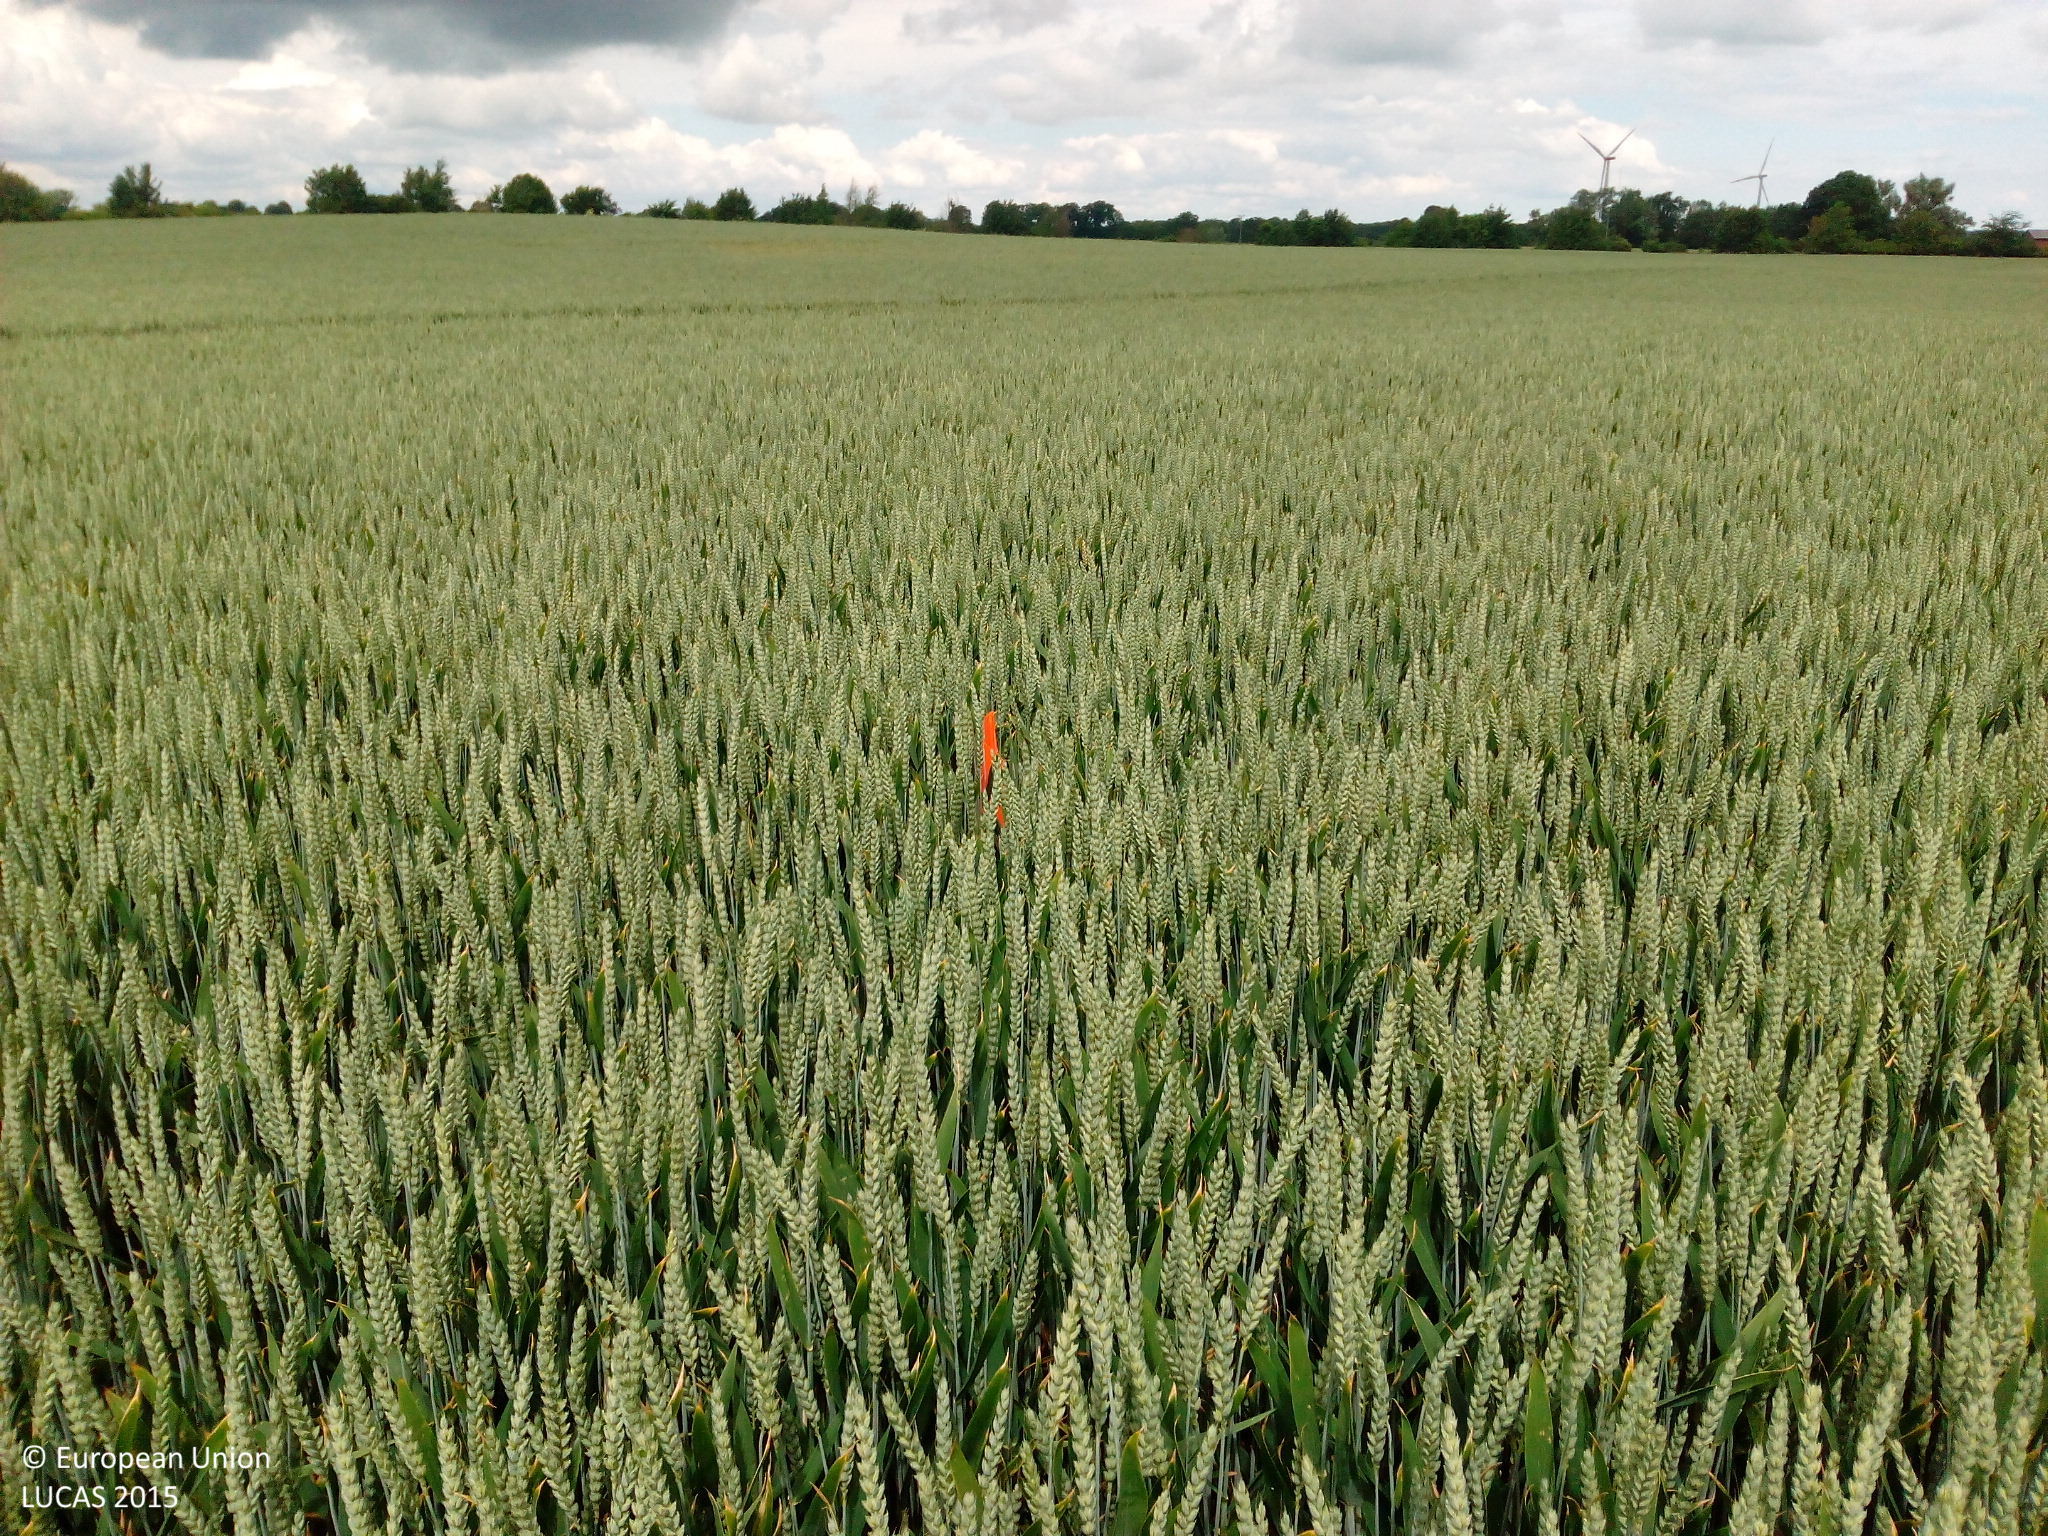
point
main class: Cropland
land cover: Common wheat
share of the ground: > 75 %
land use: Agriculture (excluding fallow land and kitchen gardens)
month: June
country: DE
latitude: 53.8100
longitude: 11.1384
